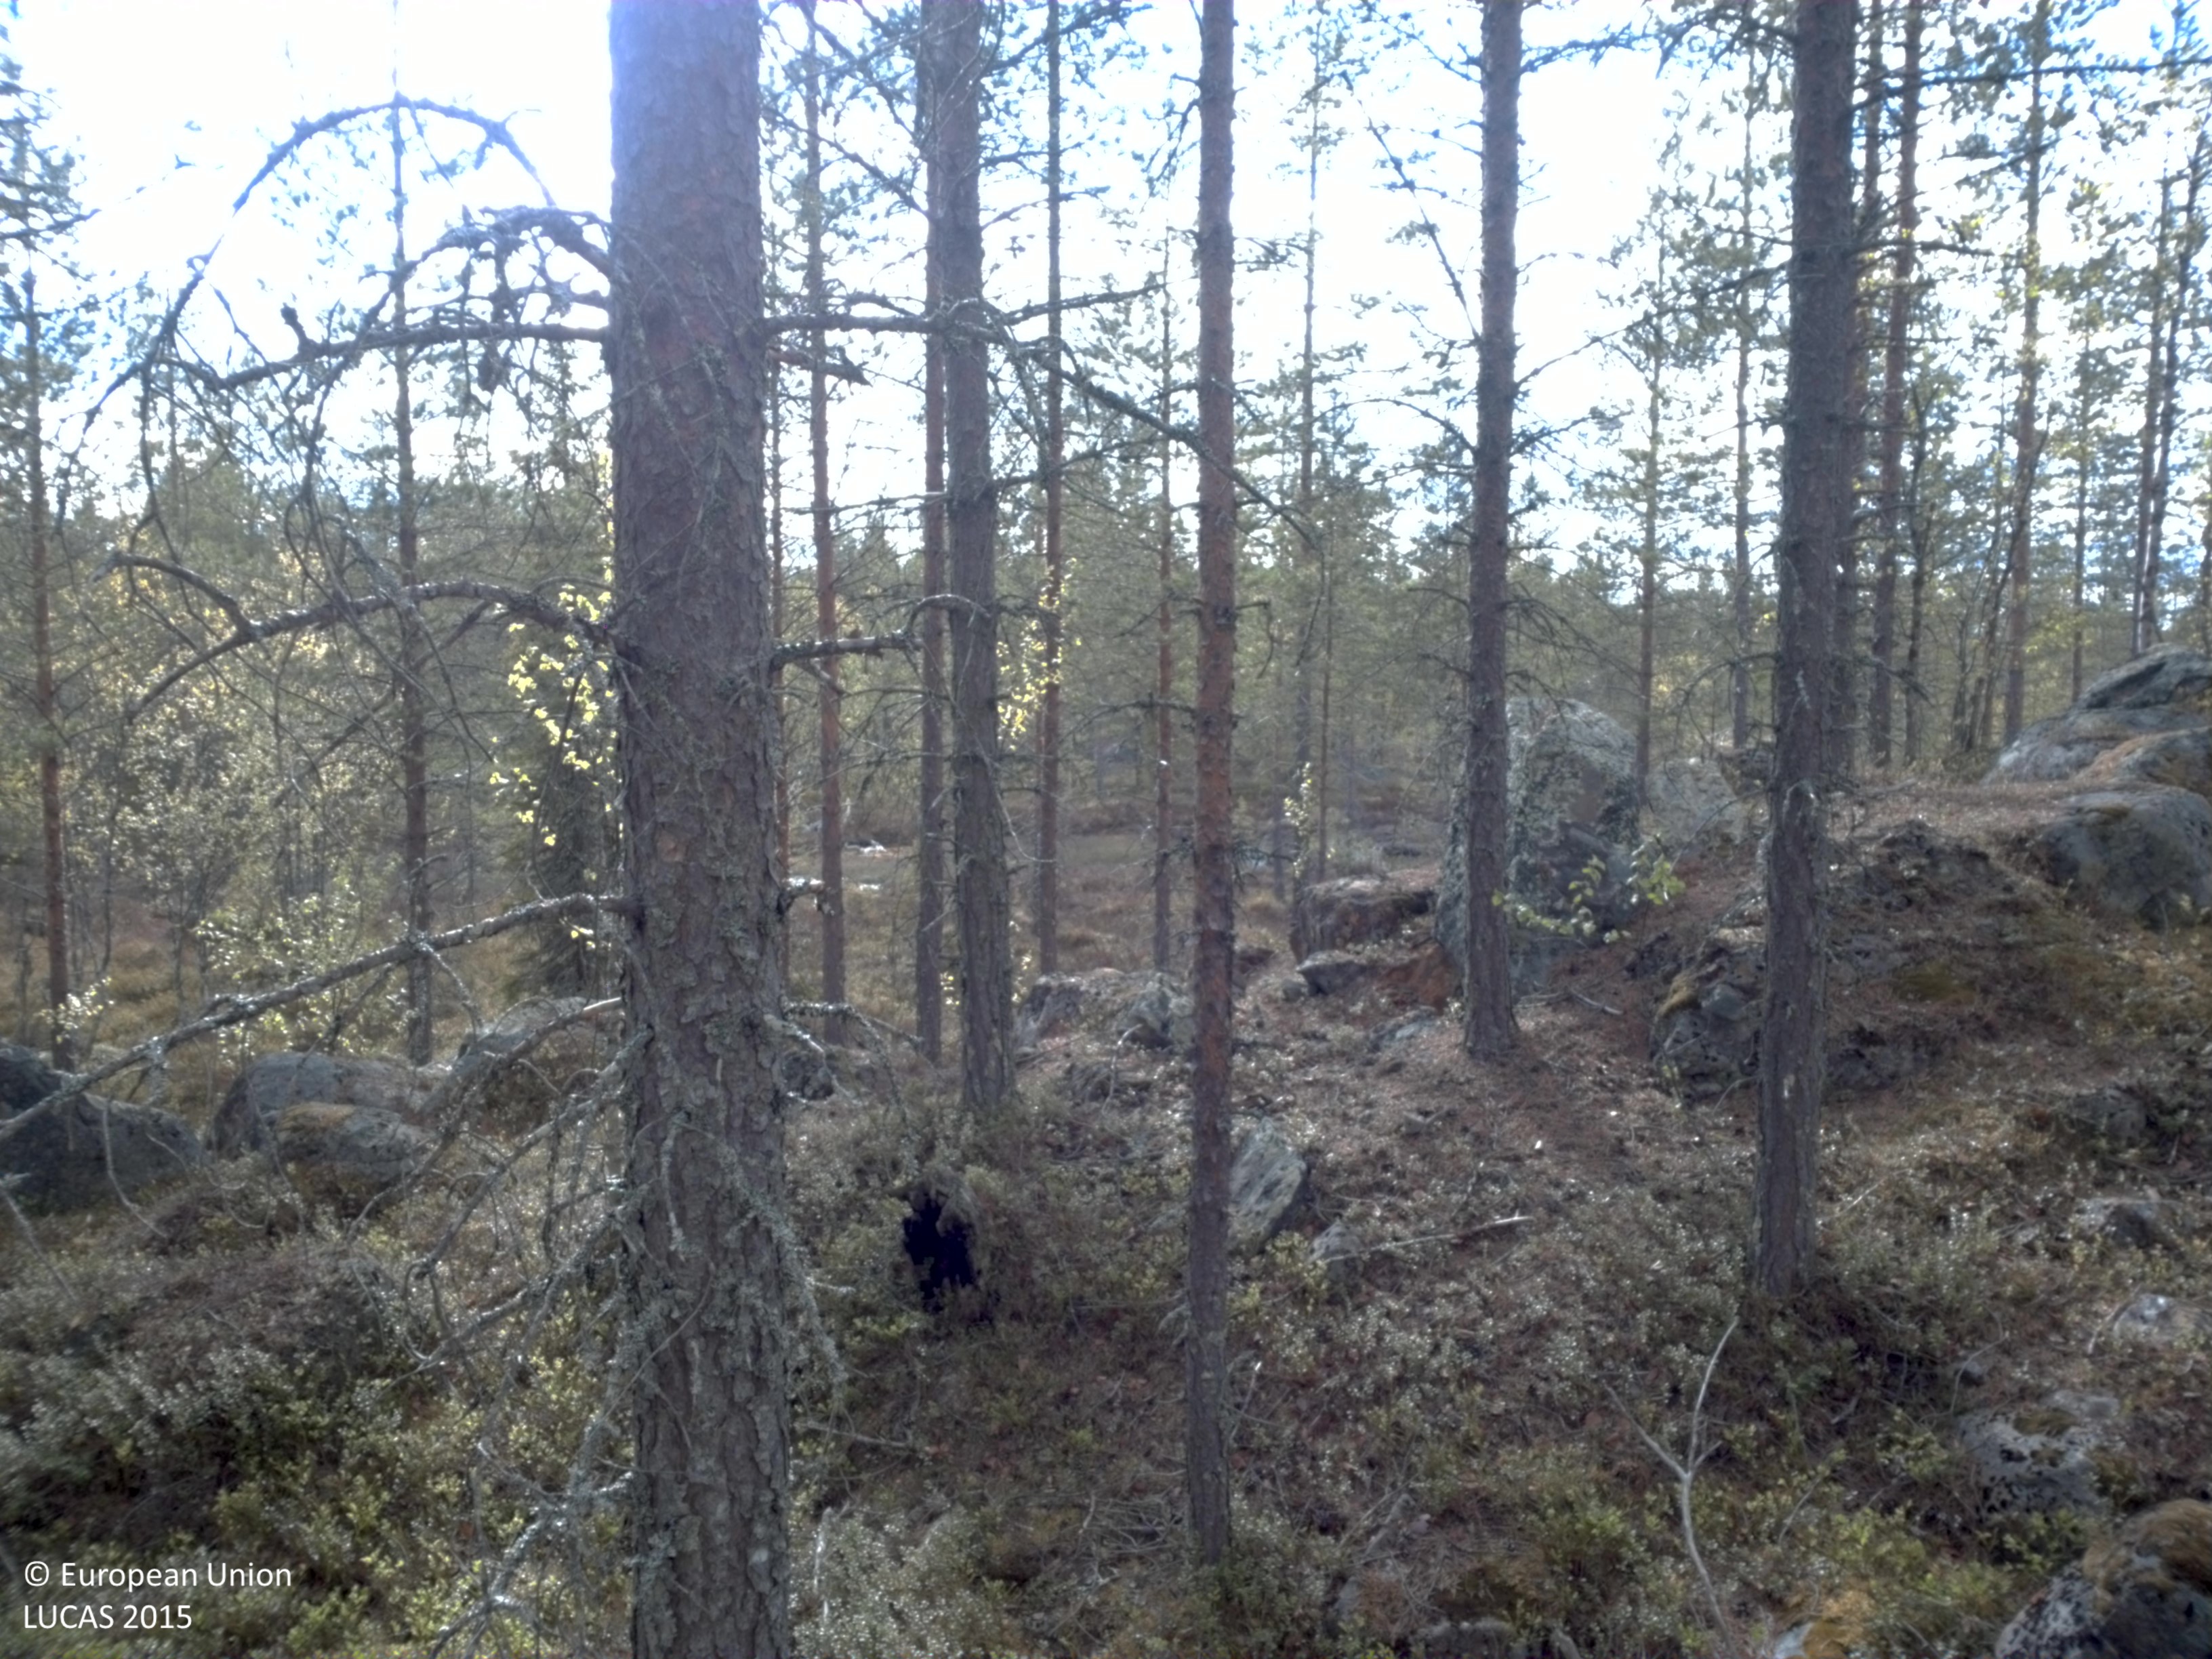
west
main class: Woodland
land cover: Pine dominated coniferous woodland
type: boreal forest
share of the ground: 25 - 50 %
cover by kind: shrubs 35 %, coniferous forest trees 30 %, unconsolidated bare surface 15 %, lichens and mosses 10 %, broadleaved forest trees 5 %, herbaceous plants 5 %
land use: Forestry
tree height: > 5 m
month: June
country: SE
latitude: 64.3607
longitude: 17.6114
